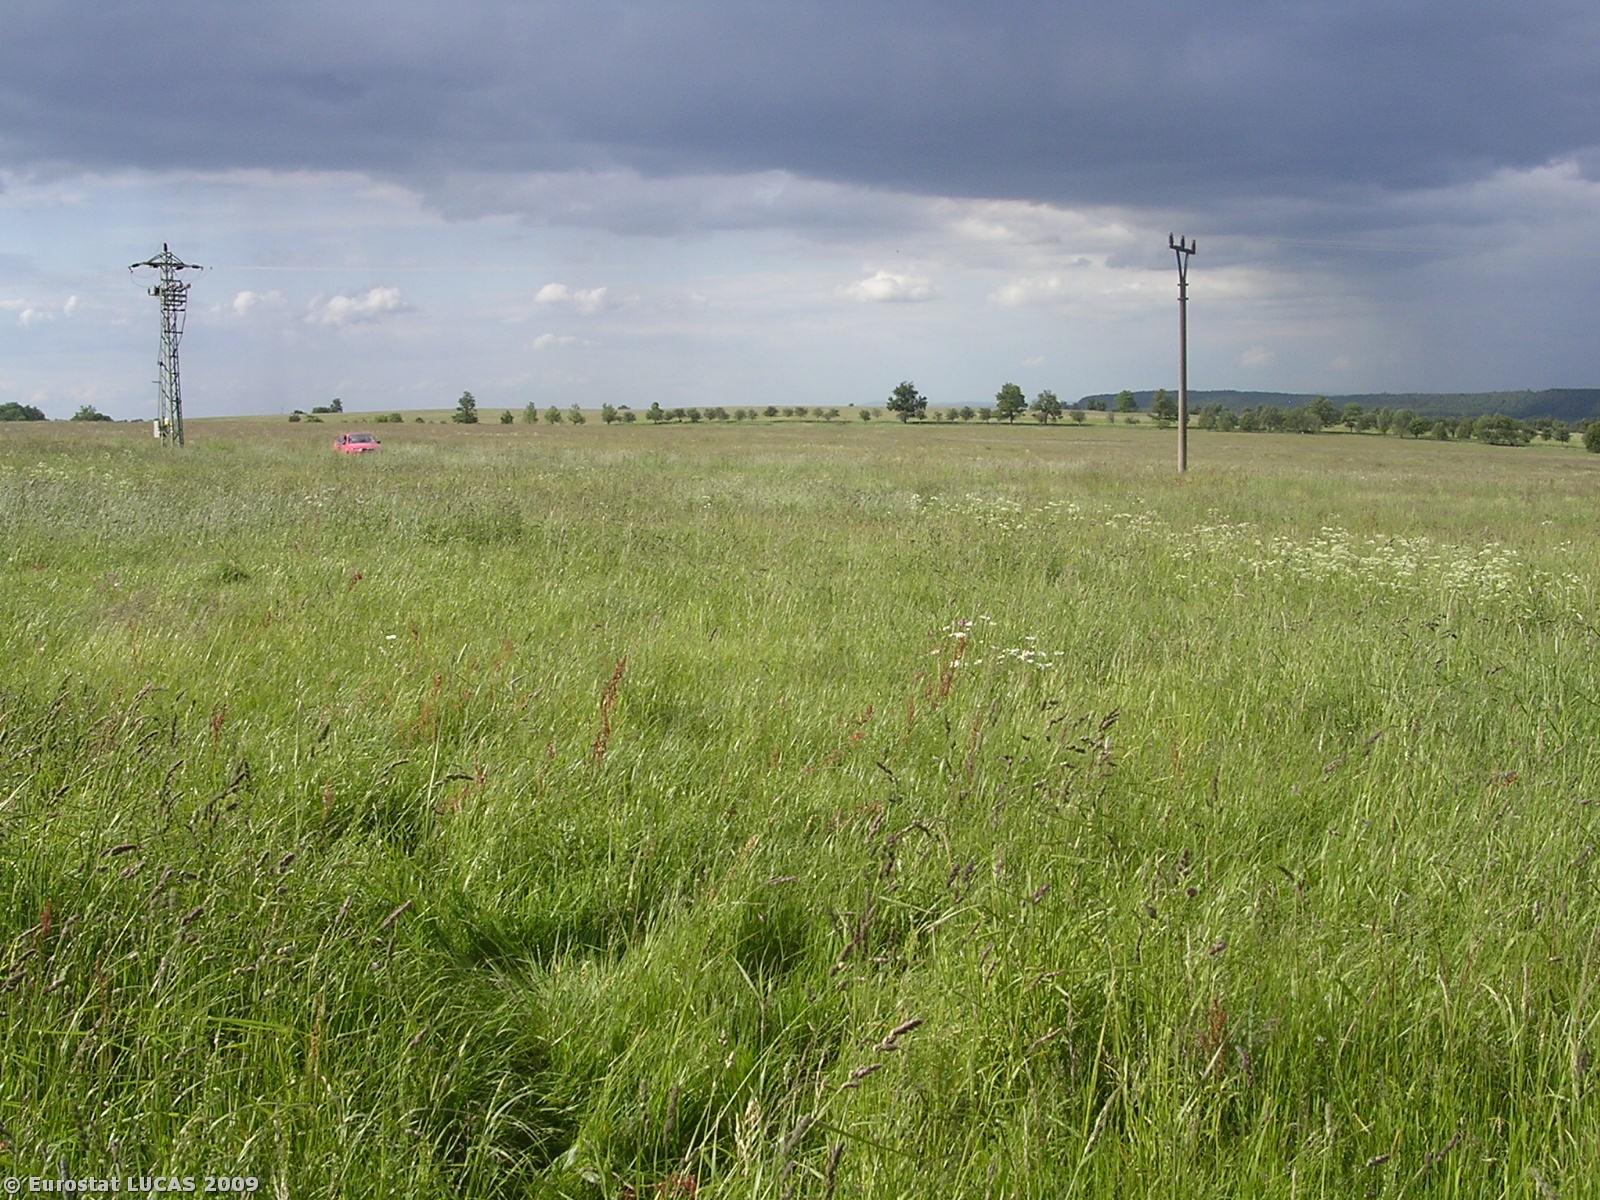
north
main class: Grassland
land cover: Grassland without tree/shrub cover
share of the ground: > 75 %
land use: Agriculture (excluding fallow land and kitchen gardens)
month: June
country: CZ
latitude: 50.7807
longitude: 13.9864
